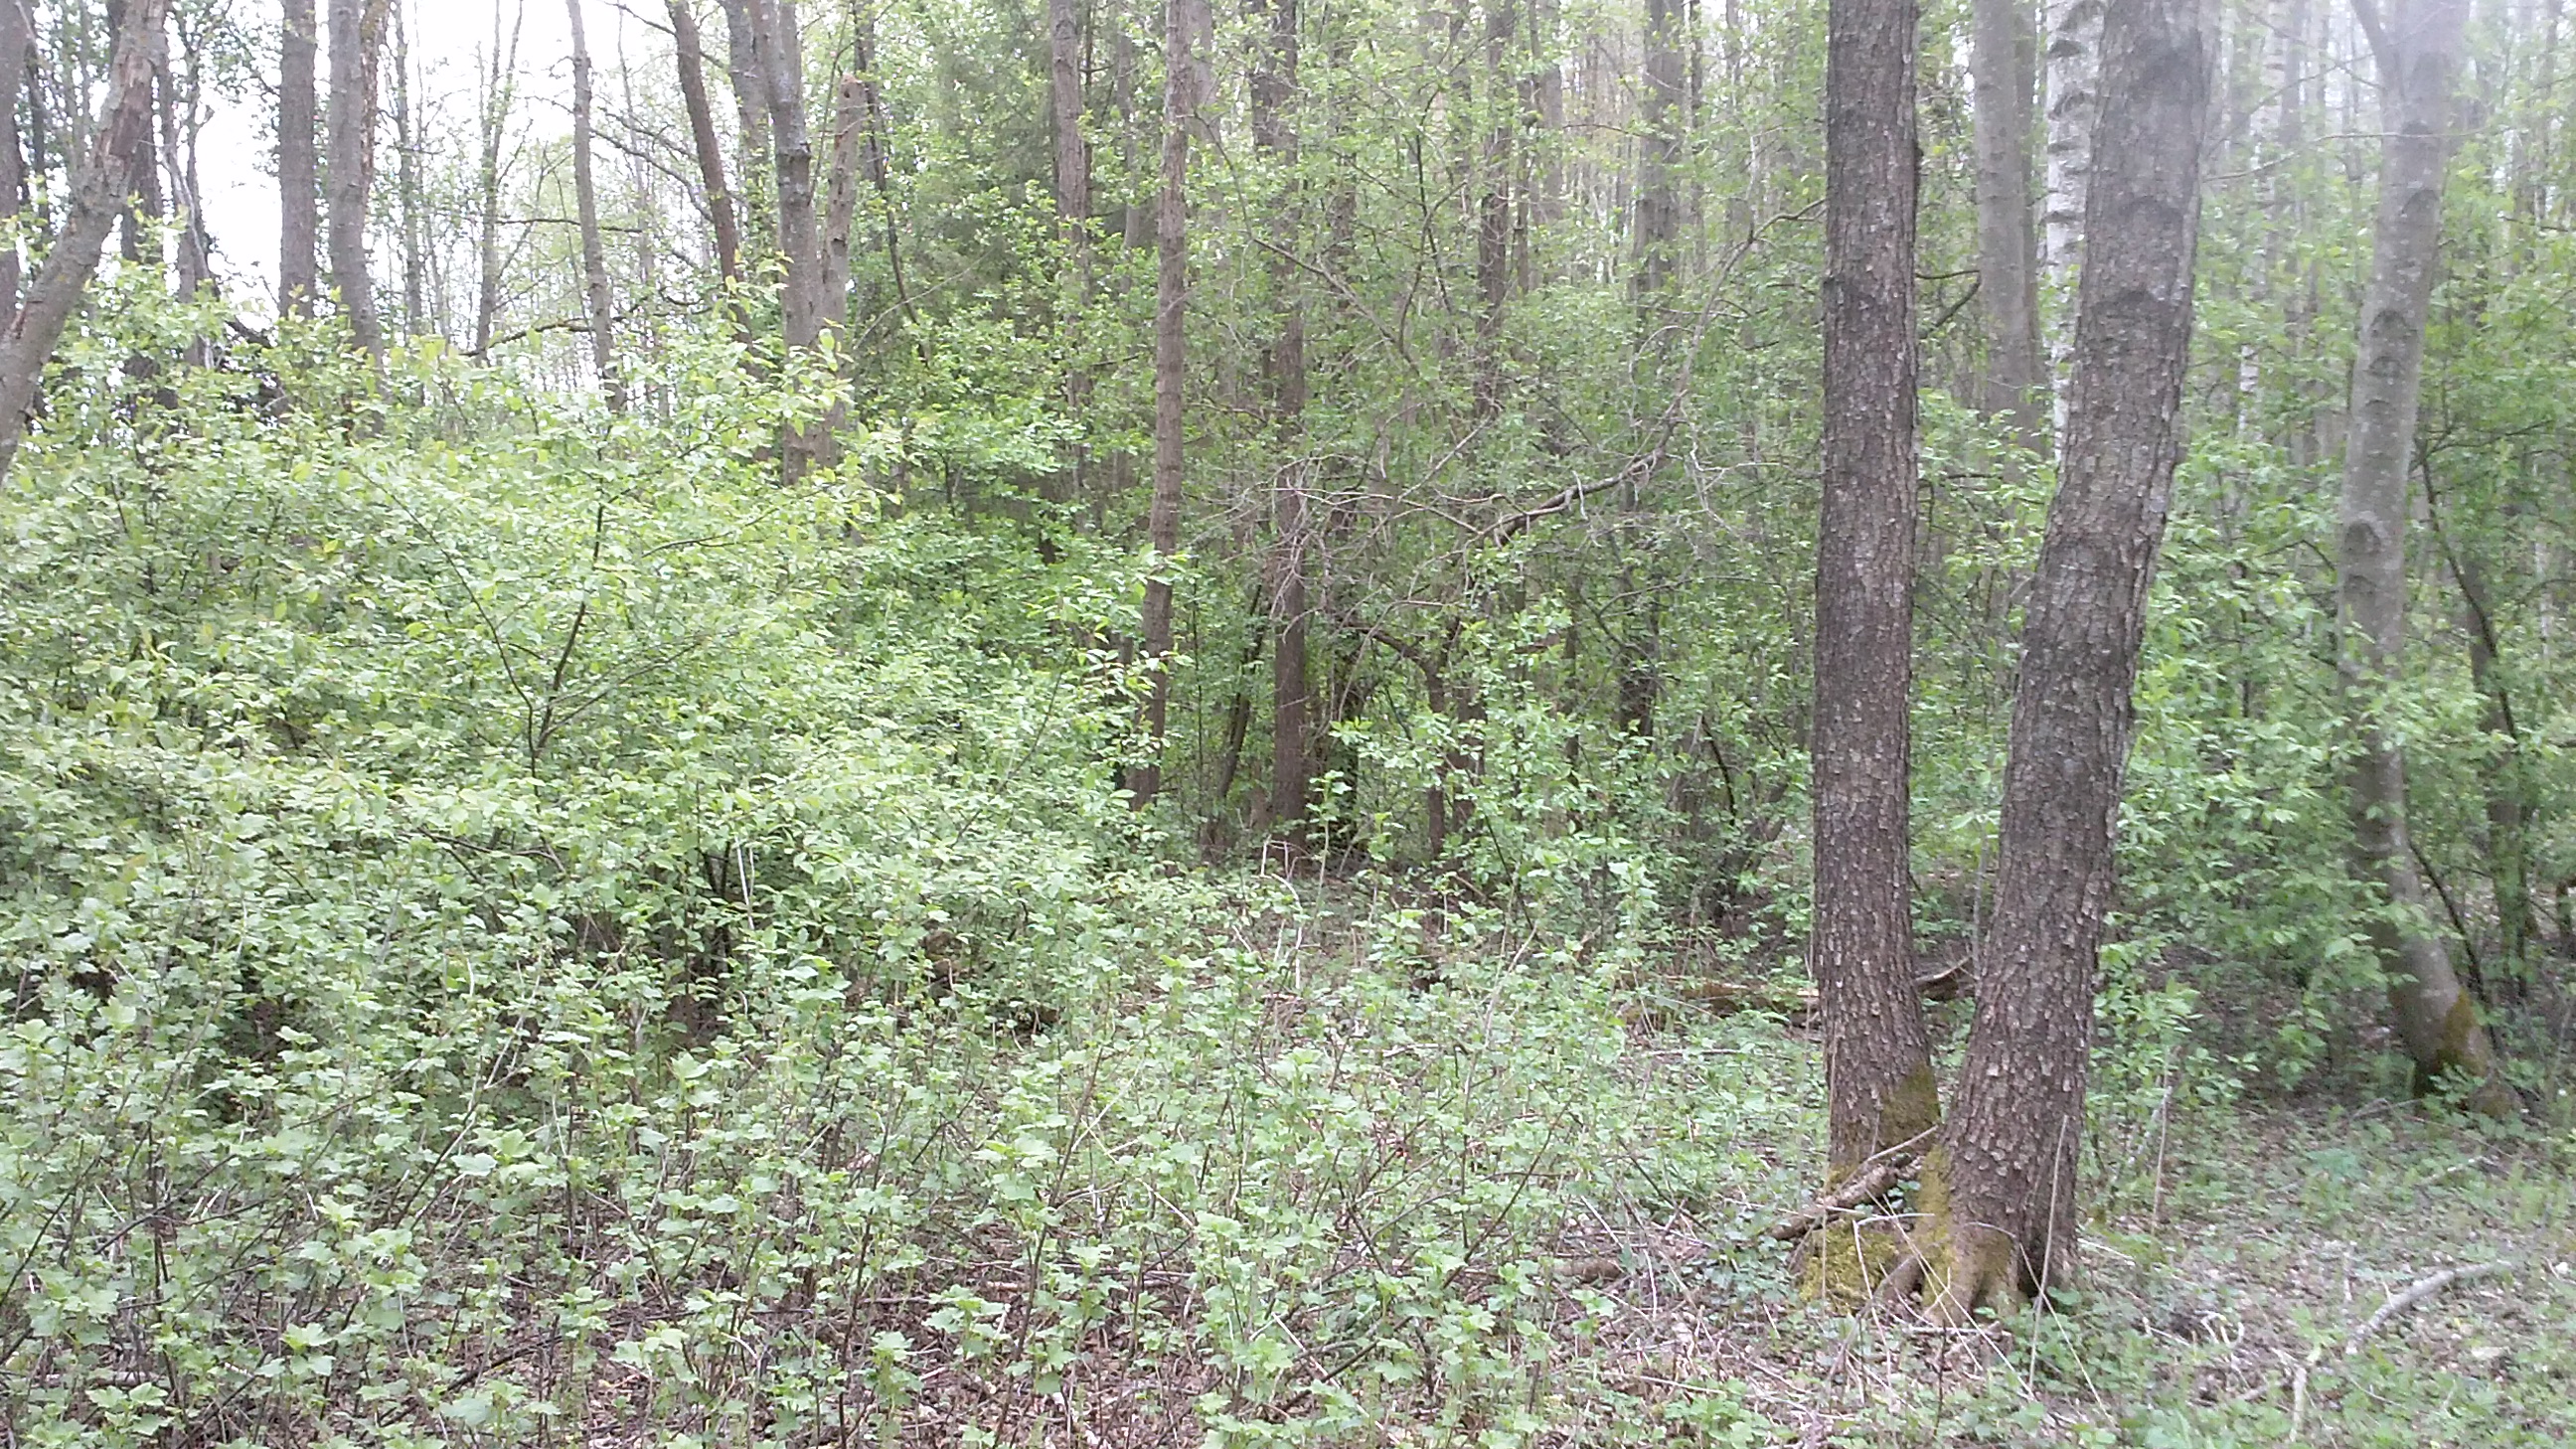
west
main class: Woodland
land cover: Broadleaved woodland
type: non-riverine alder, birch or aspen forest
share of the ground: > 75 %
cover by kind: broadleaved forest trees 90 %, shrubs 10 %
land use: Forestry
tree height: > 5 m
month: May
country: LV
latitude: 55.9706
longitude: 27.0716
